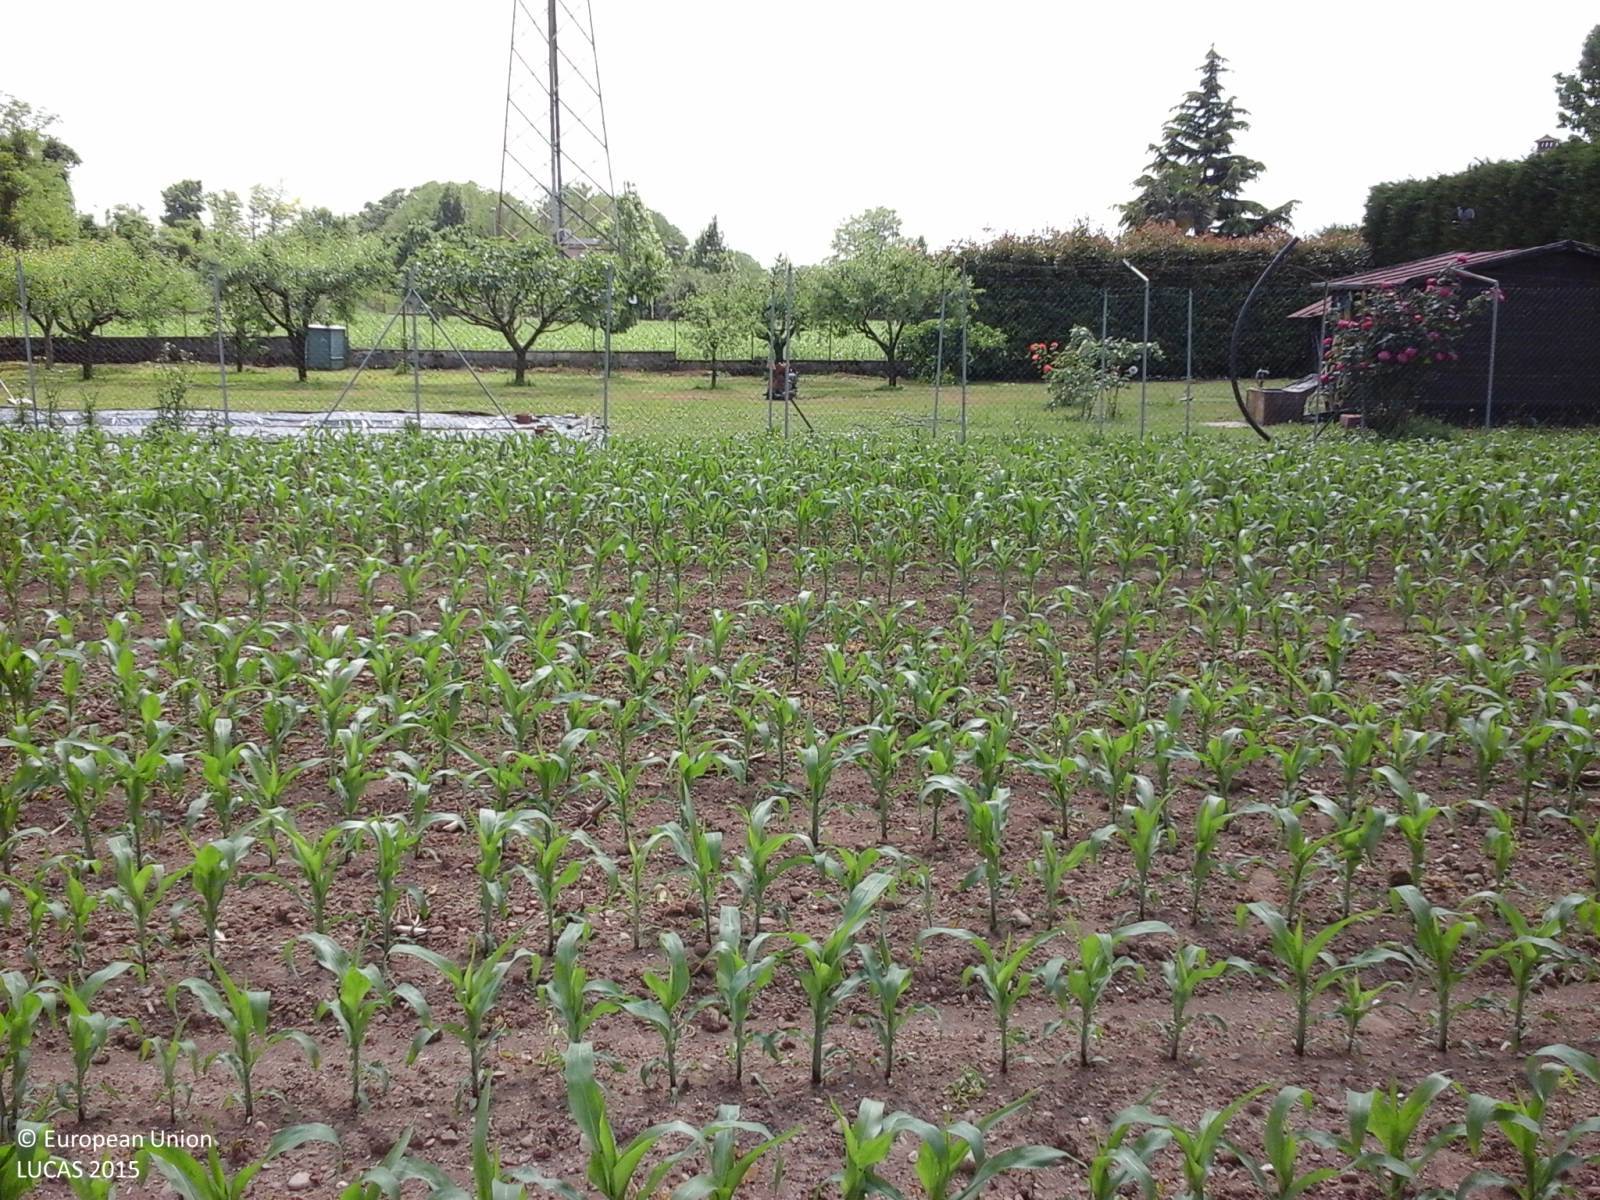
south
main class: Cropland
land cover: Maize
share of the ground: 50 - 75 %
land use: Agriculture (excluding fallow land and kitchen gardens)
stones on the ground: < 10 %
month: May
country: IT
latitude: 46.0130
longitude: 13.2639
